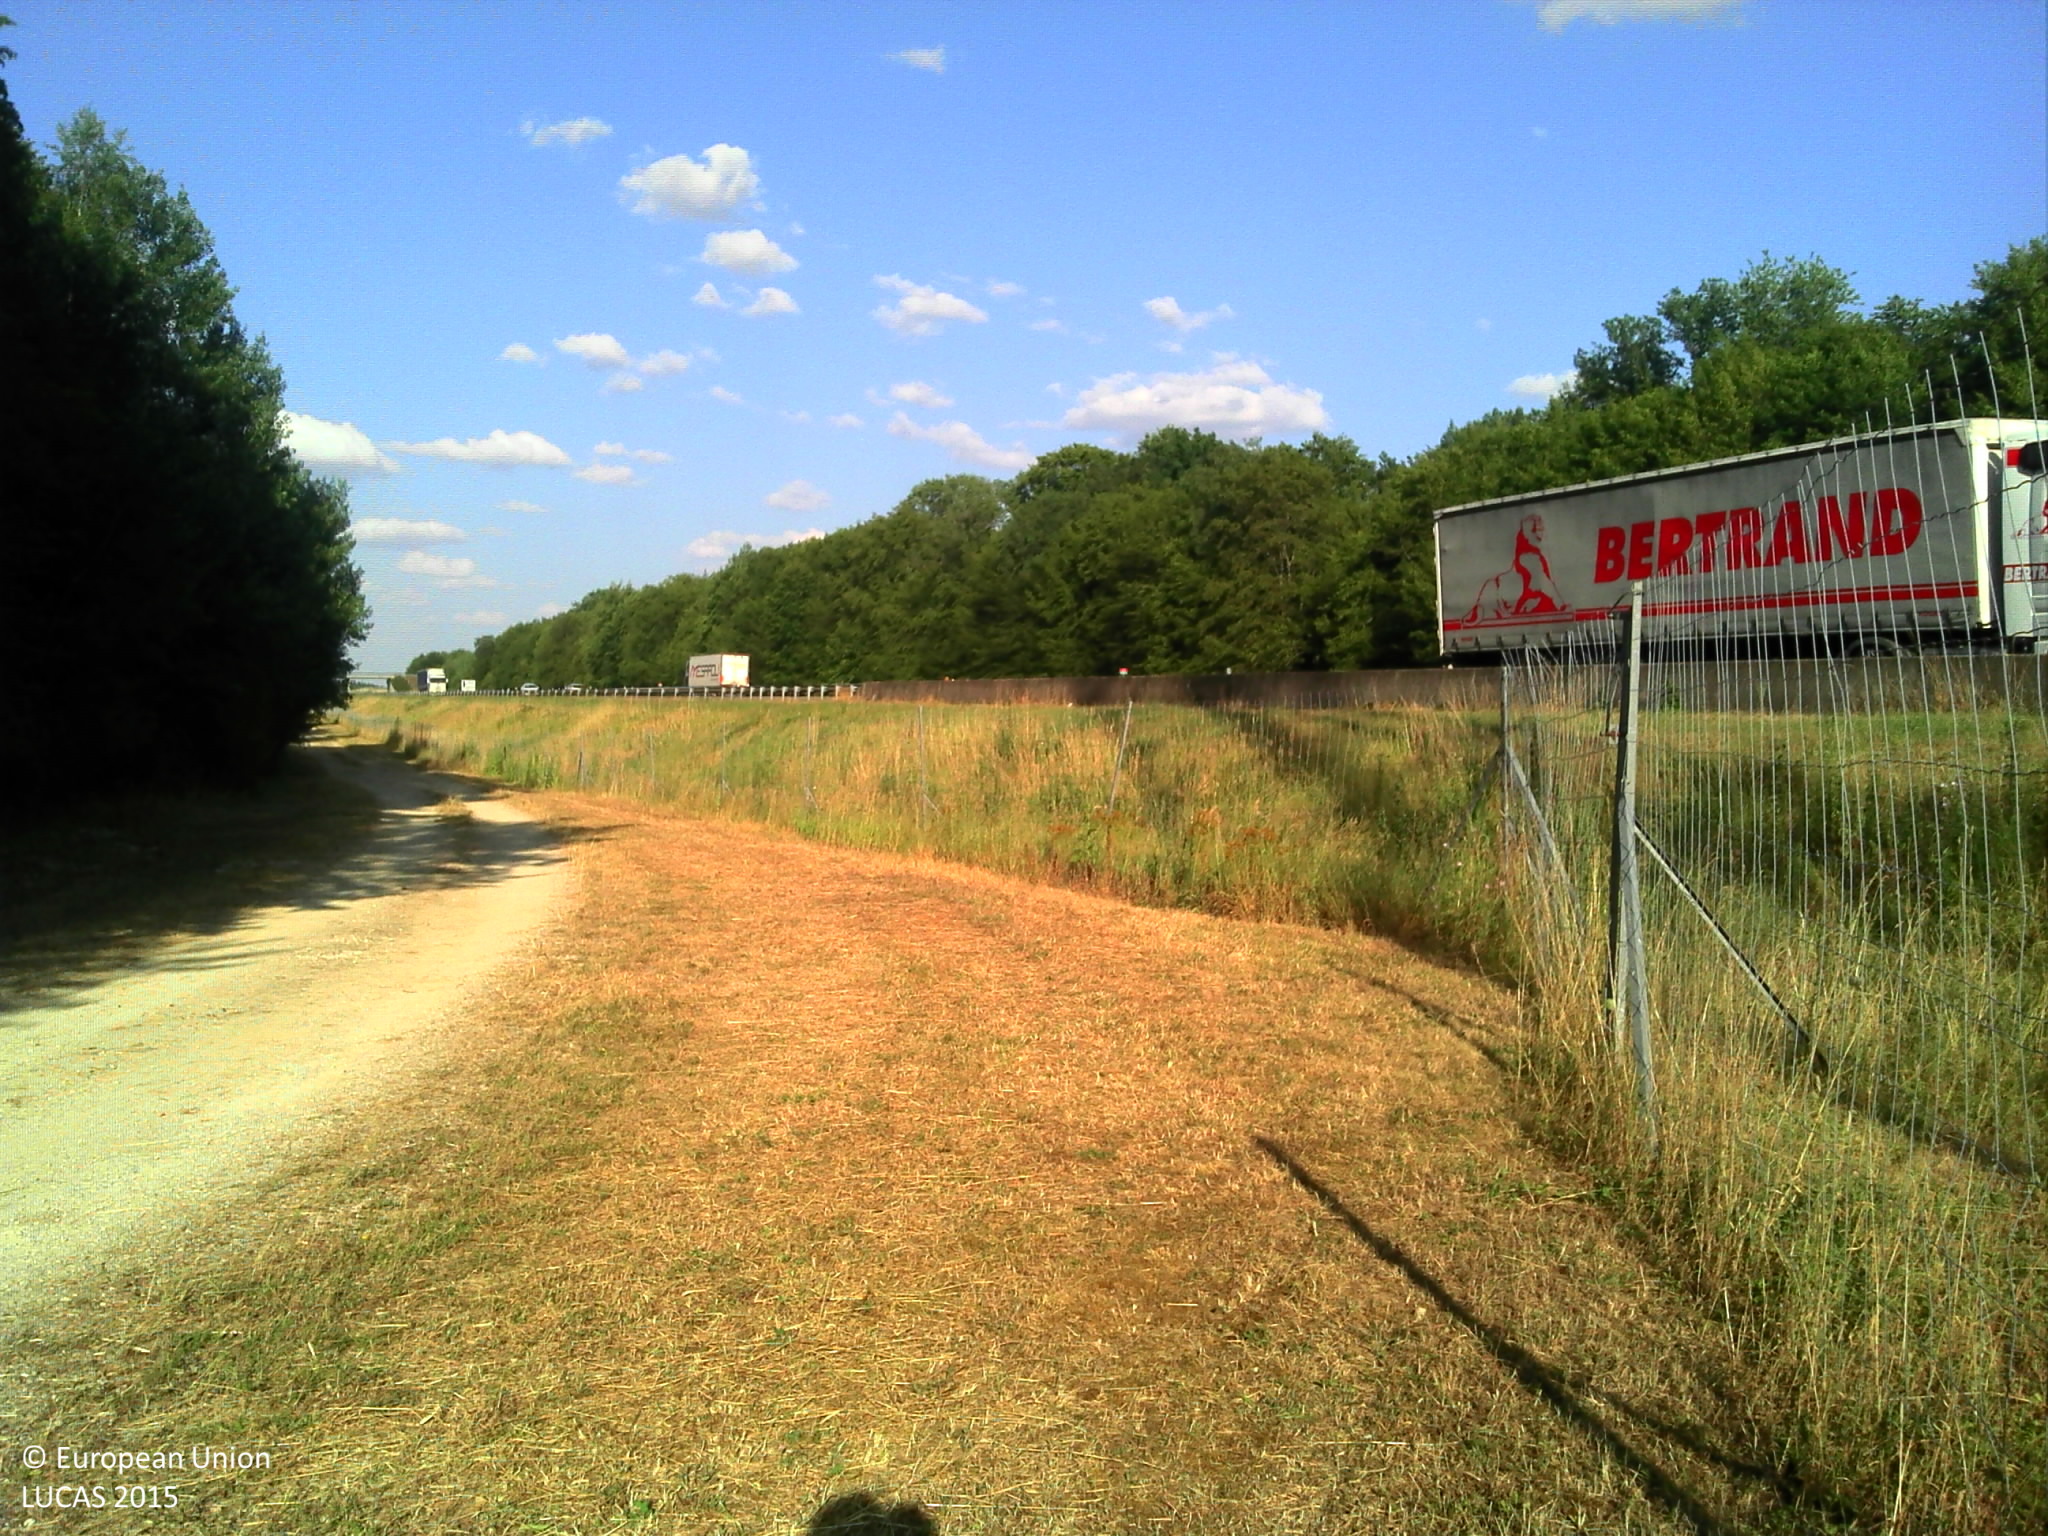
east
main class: Grassland
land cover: Grassland without tree/shrub cover
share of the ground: > 75 %
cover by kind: herbaceous plants 100 %
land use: Telecommunication
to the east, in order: Grassland without tree/shrub cover; Fences; Grassland without tree/shrub cover; Fences; Paved roads, cycling and walking lanes; Fences; Grassland without tree/shrub cover
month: July
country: FR
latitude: 48.0391
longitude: 5.0230
